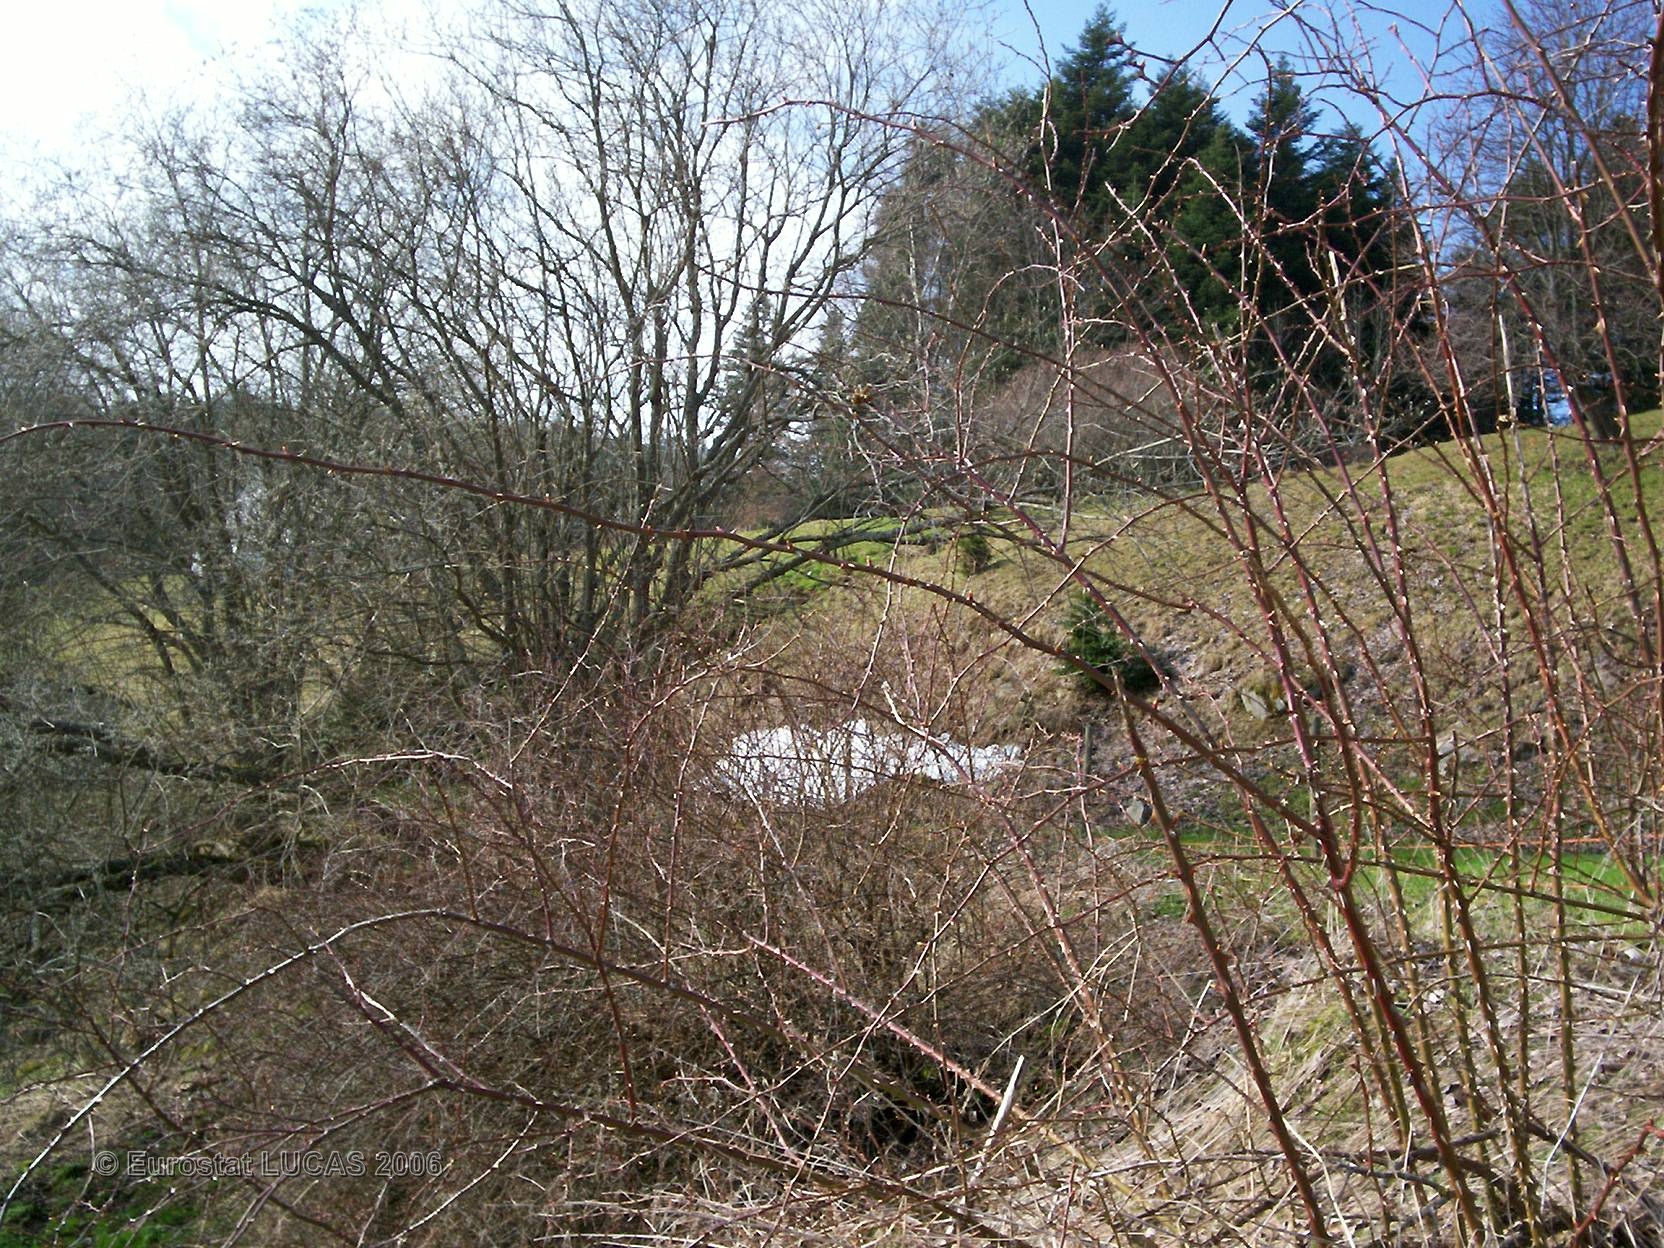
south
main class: Grassland
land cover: Grassland with sparse tree/shrub cover
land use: Agriculture (excluding fallow land and kitchen gardens)
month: April
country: FR
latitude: 48.0958
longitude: 7.1142
